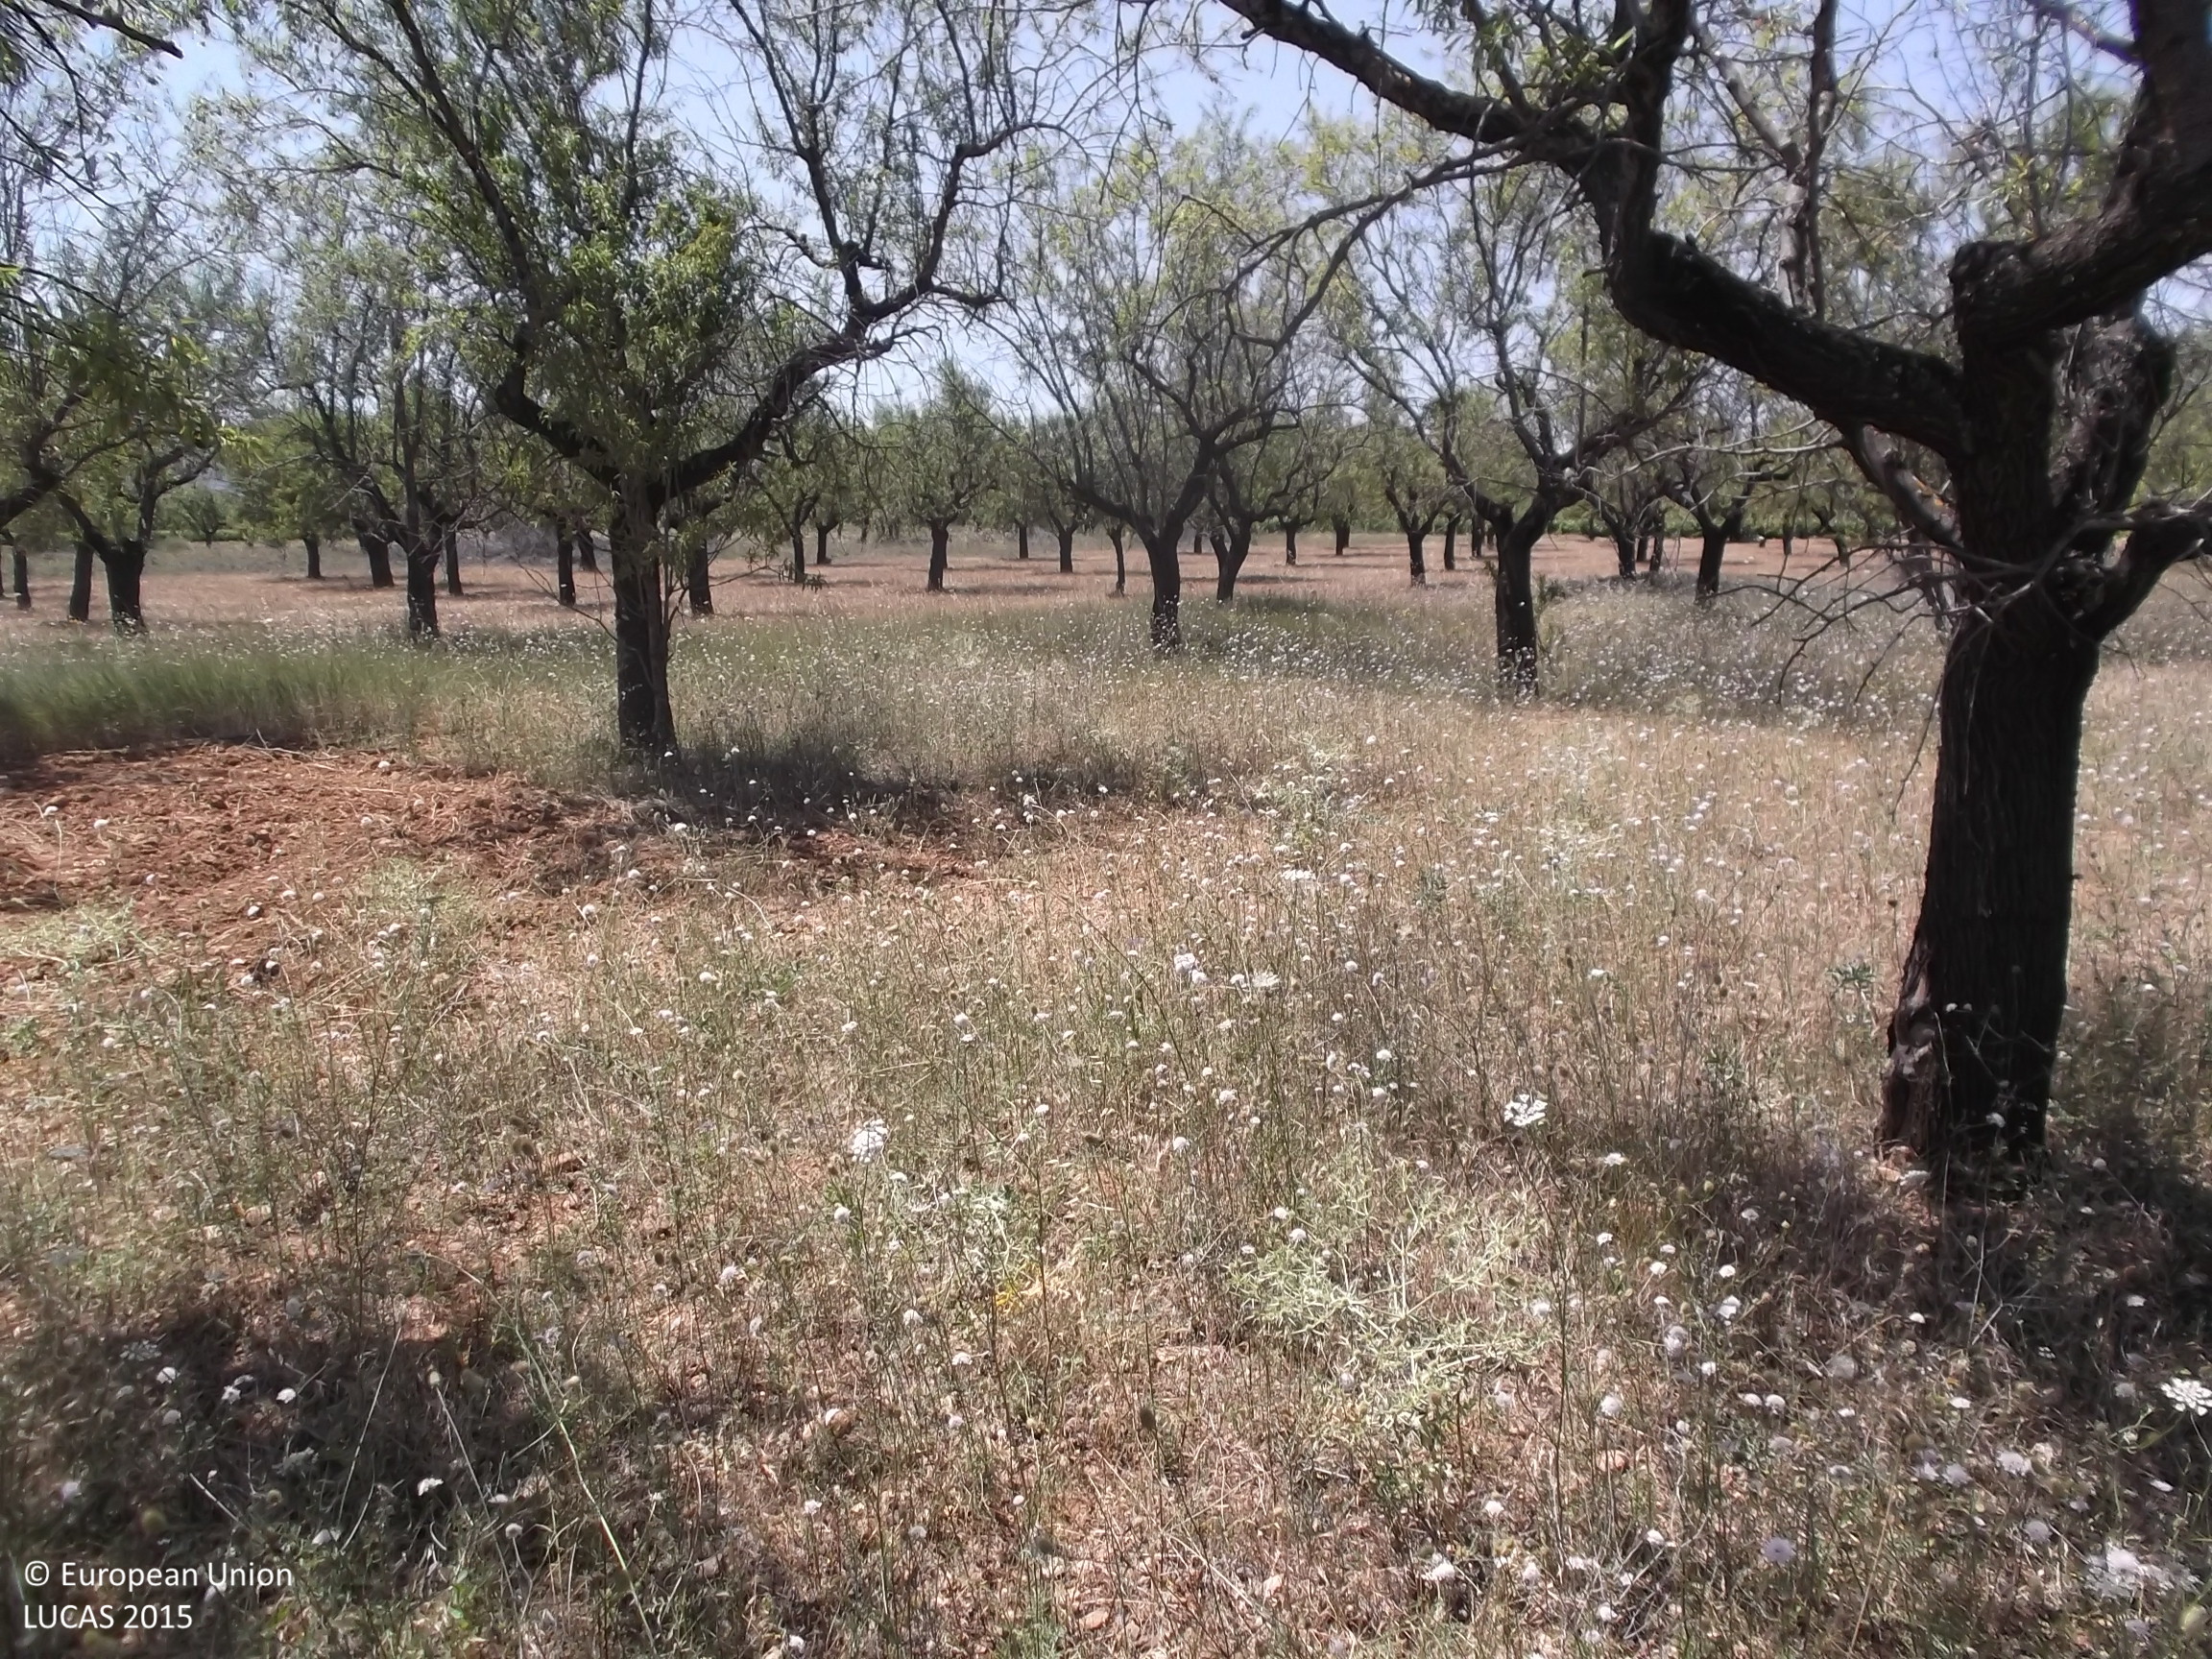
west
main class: Cropland
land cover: Nuts trees
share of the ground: 10 - 25 %
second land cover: Spontaneously vegetated surfaces
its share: > 75 %
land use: Agriculture (excluding fallow land and kitchen gardens)
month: June
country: ES
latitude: 42.2927
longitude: -2.0826
